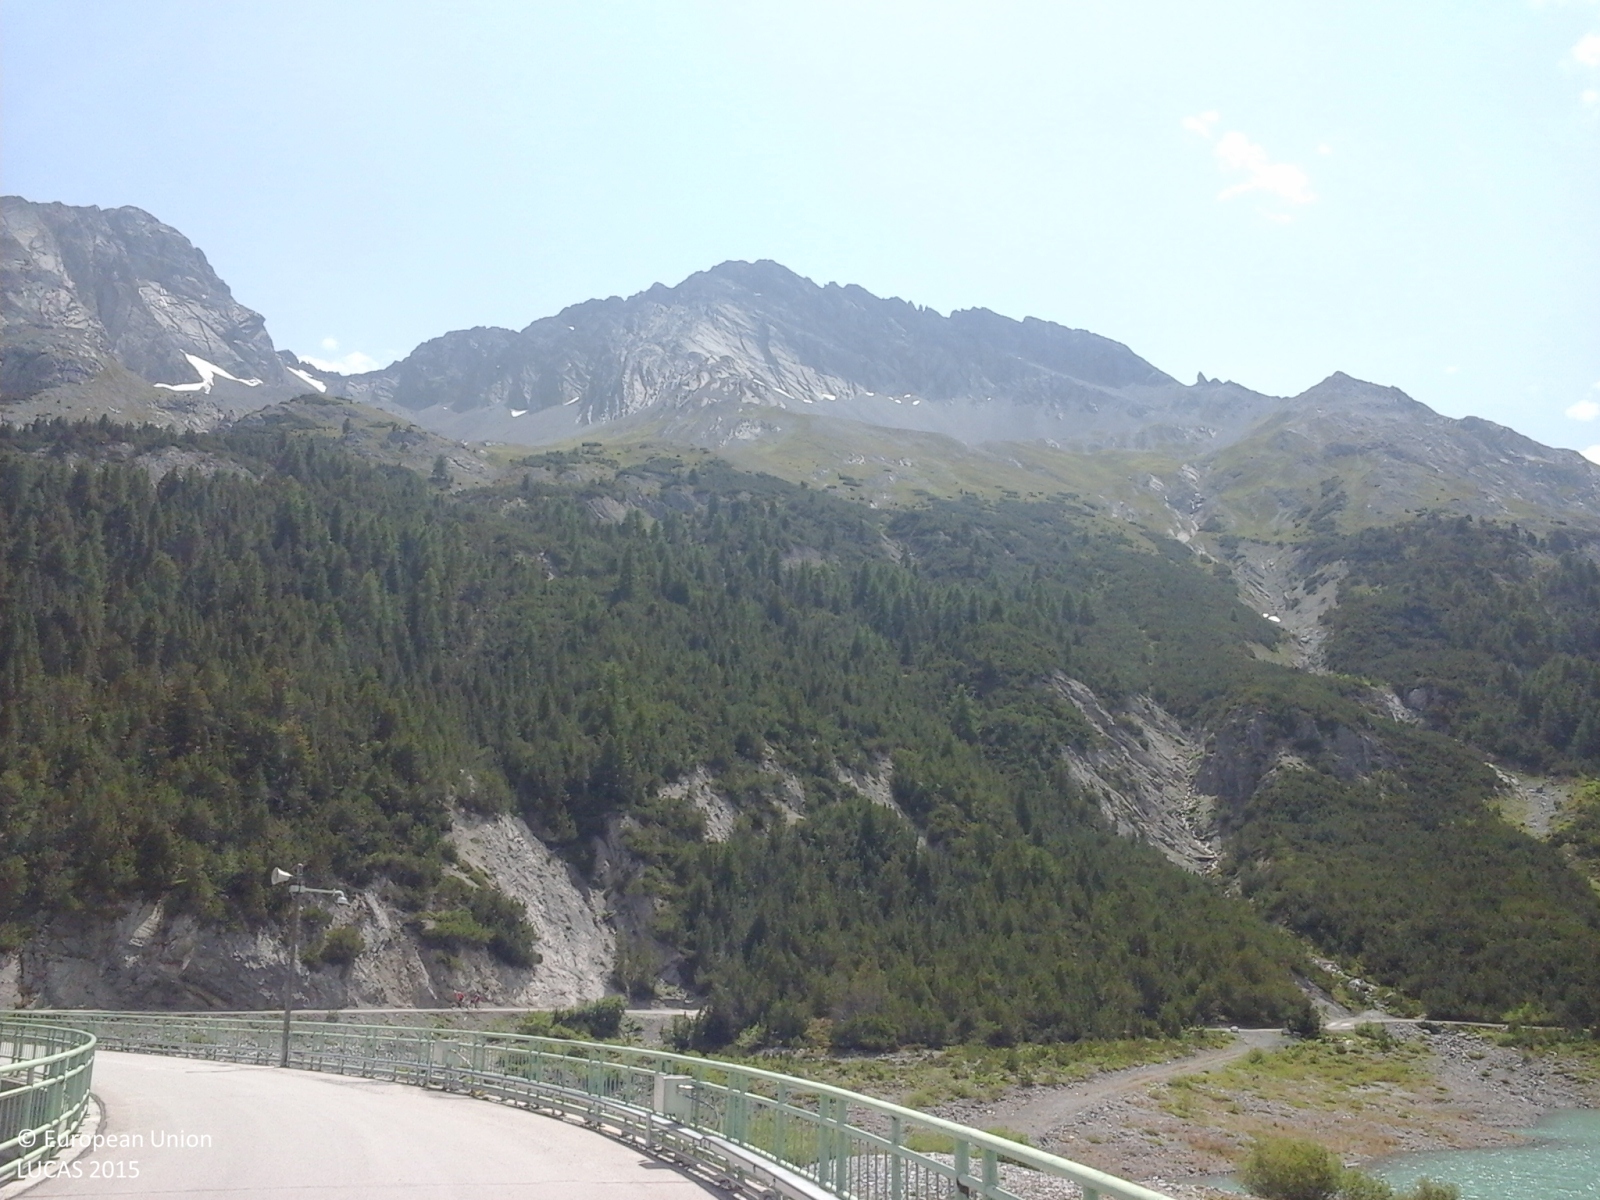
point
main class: Woodland
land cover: Spruce dominated coniferous woodland
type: alpine coniferous forest
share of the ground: > 75 %
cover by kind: coniferous forest trees 100 %
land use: Semi-natural and natural areas not in use
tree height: > 5 m
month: July
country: IT
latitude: 46.5310
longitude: 10.2734
